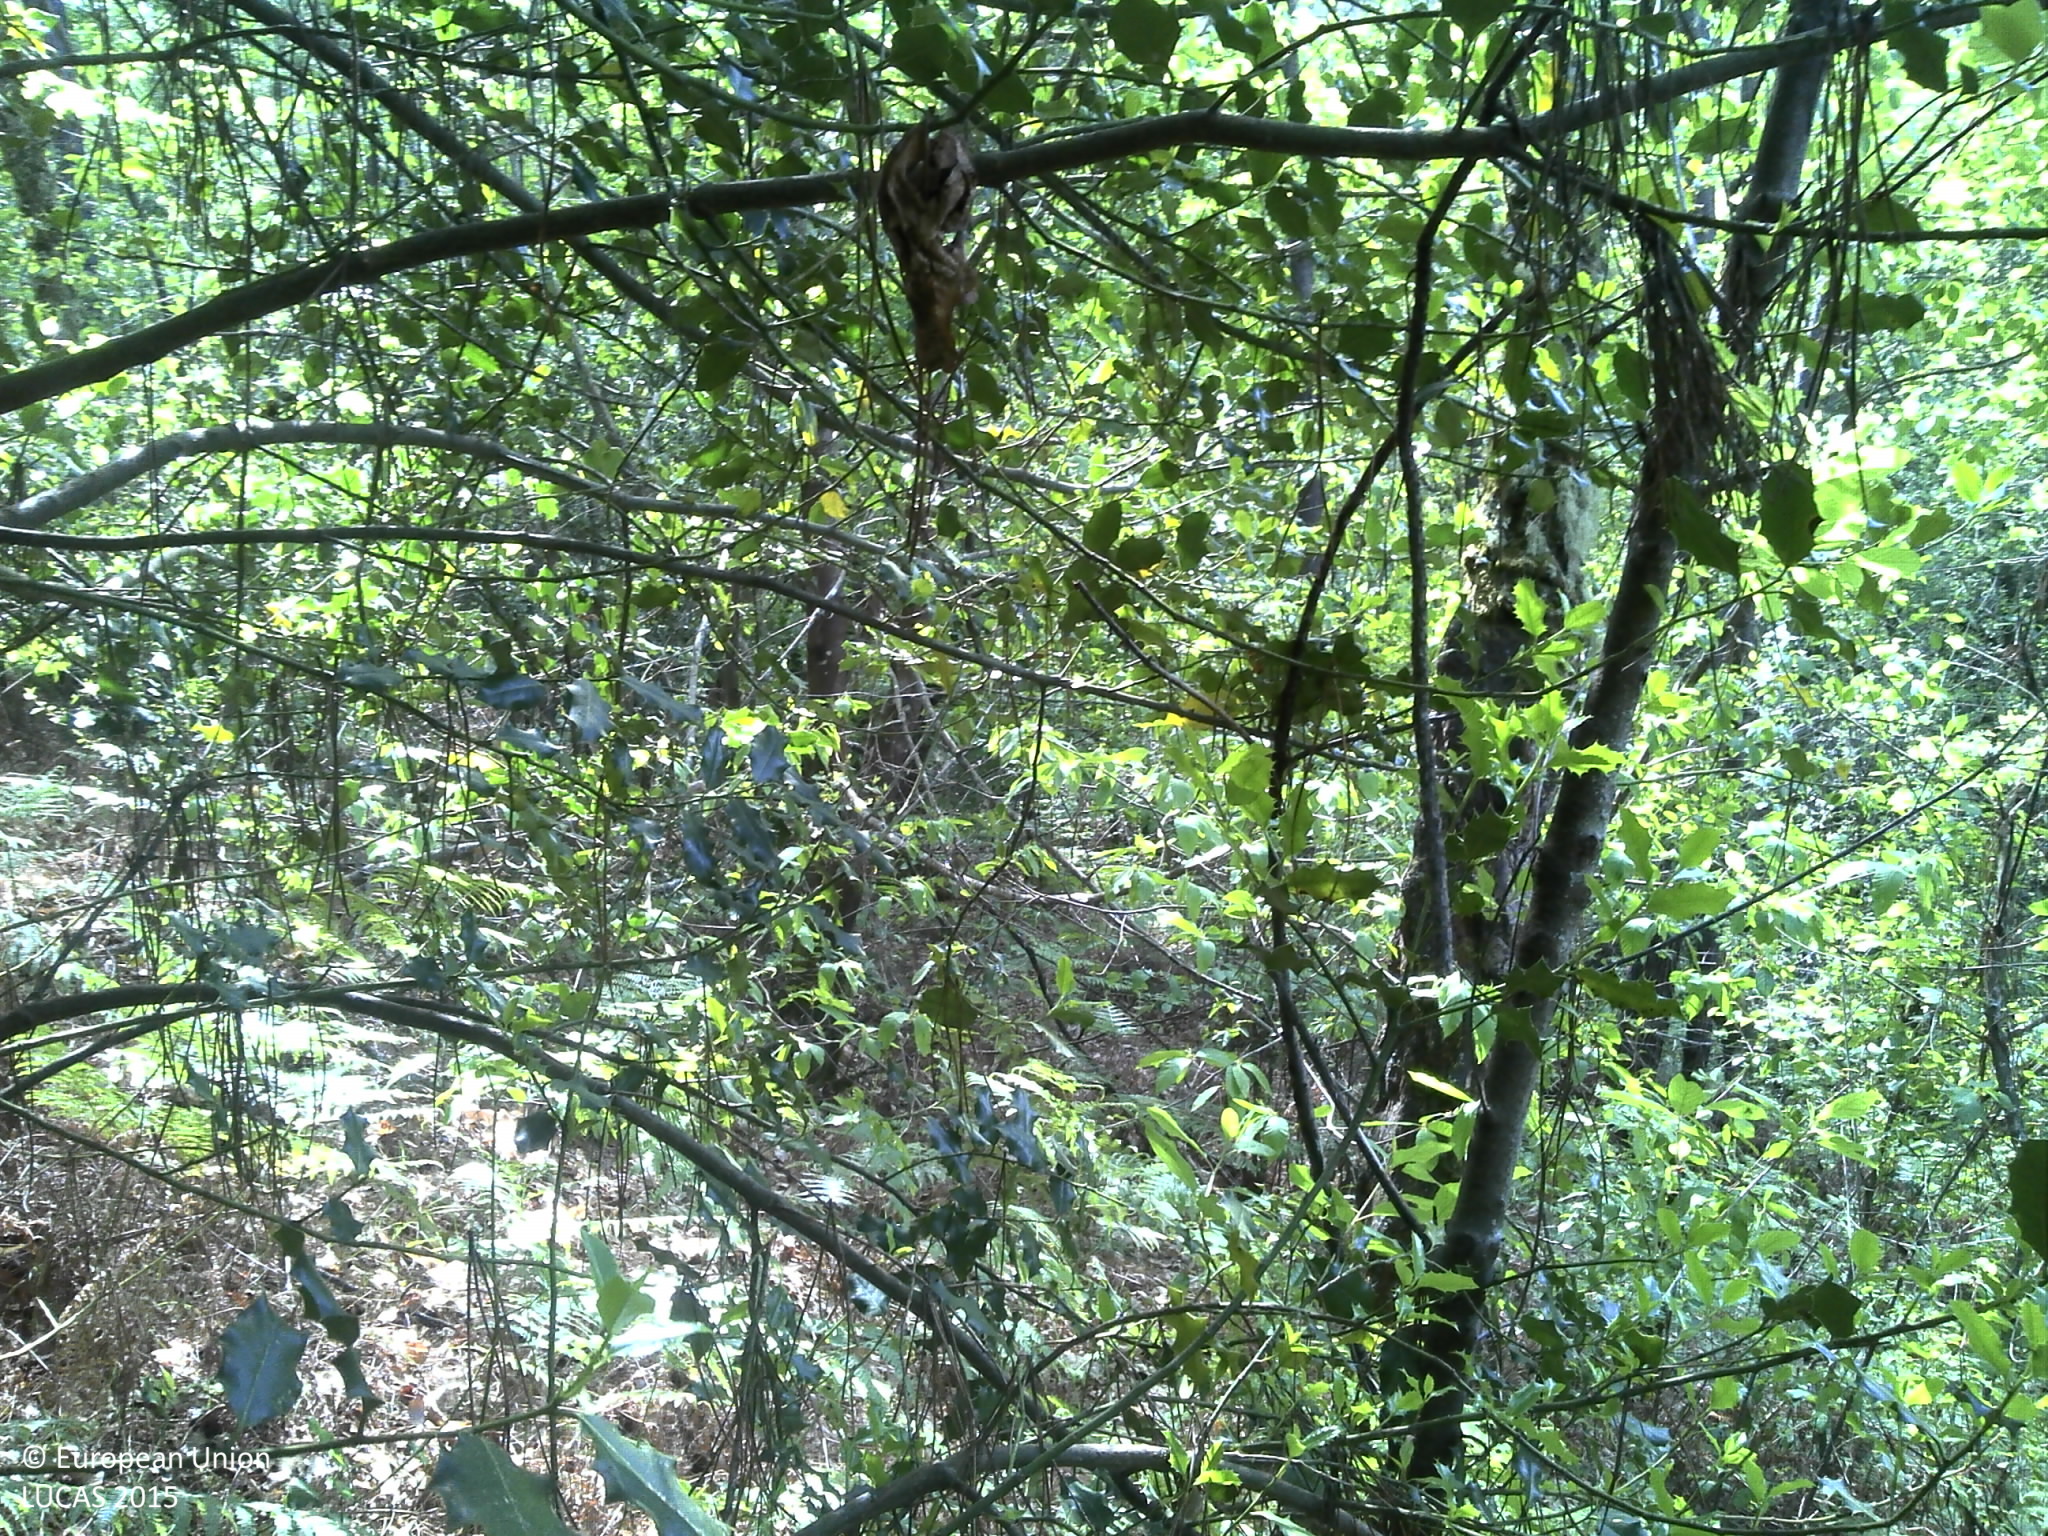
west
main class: Woodland
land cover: Broadleaved woodland
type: thermophilous deciduous forest
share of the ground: > 75 %
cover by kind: broadleaved forest trees 85 %, unconsolidated bare surface 10 %, shrubs 5 %
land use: Forestry
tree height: > 5 m
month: May
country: PT
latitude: 40.9069
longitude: -8.3400
